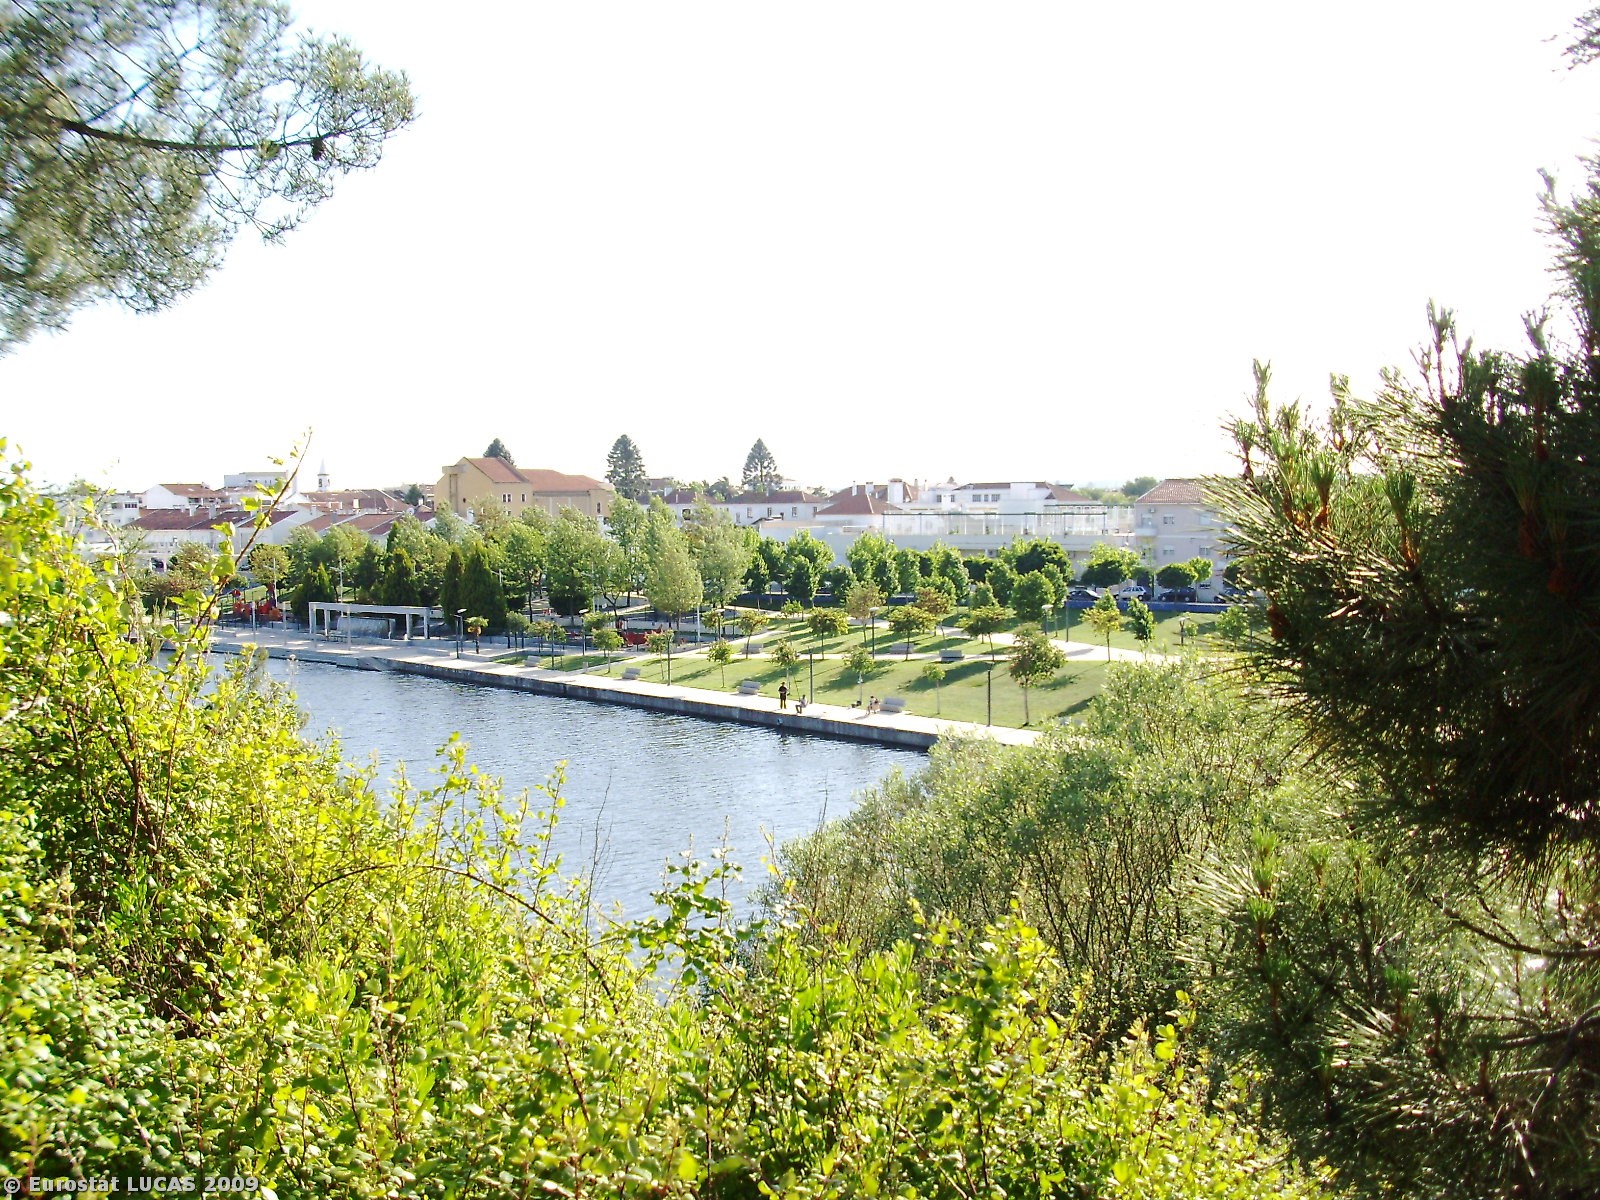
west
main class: Woodland
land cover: Mixed woodland
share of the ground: 25 - 50 %
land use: Forestry
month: May
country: PT
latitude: 39.2516
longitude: -8.0043
